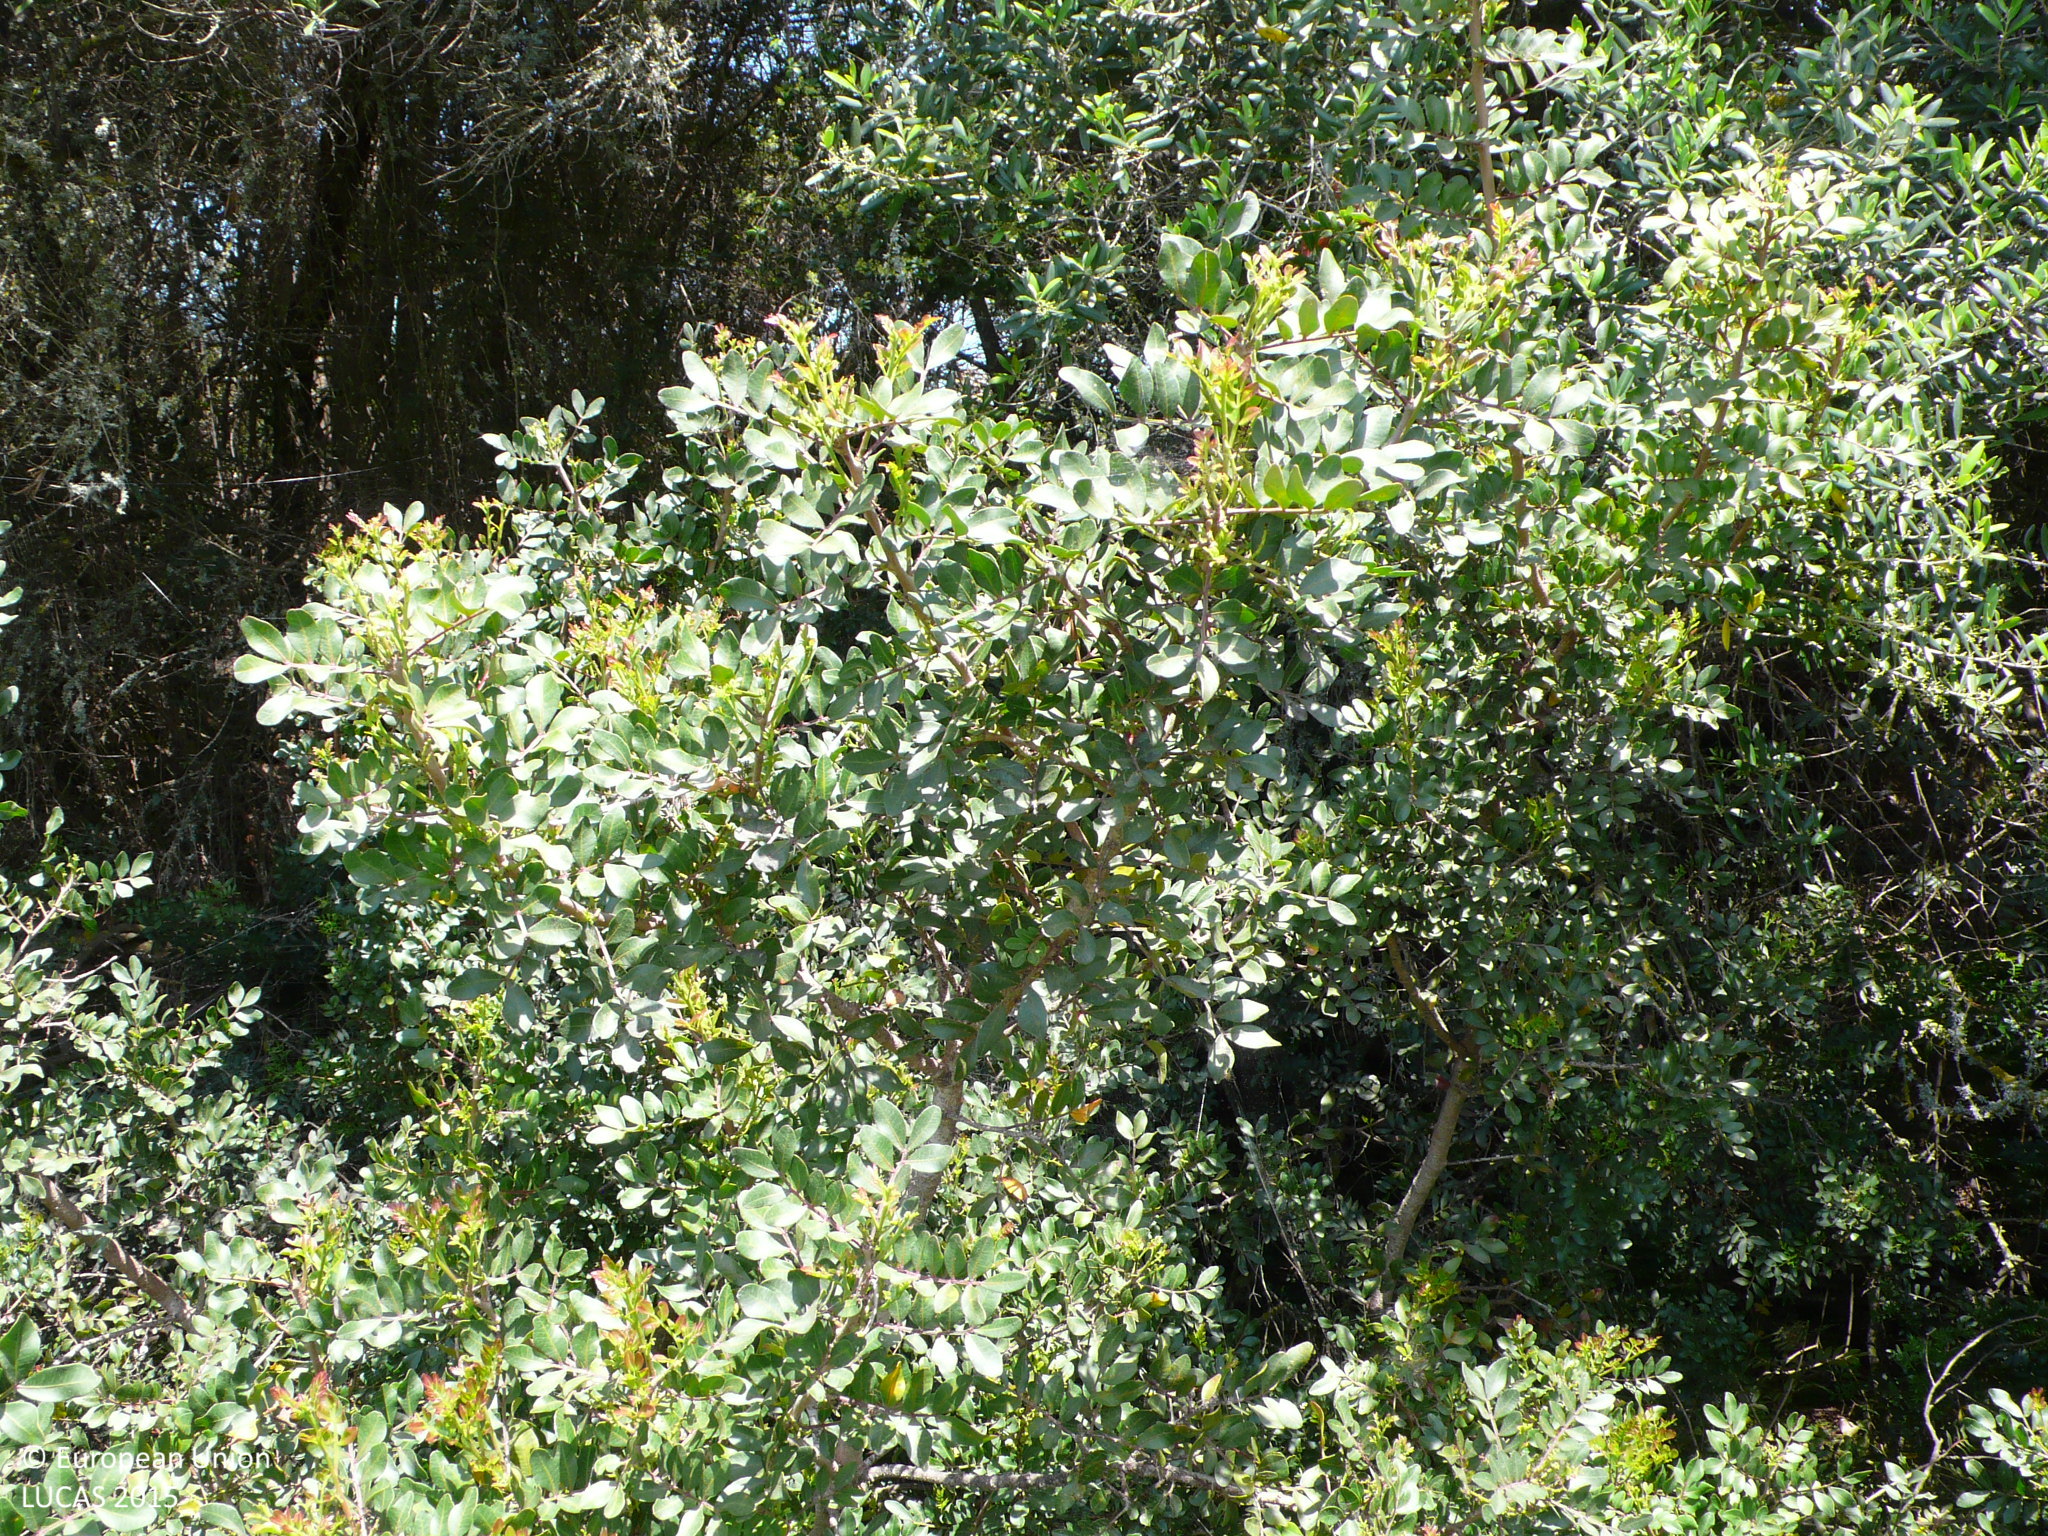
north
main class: Woodland
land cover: Broadleaved woodland
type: broadleaved evergreen forest
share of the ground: 50 - 75 %
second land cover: Grassland without tree/shrub cover
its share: 50 - 75 %
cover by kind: broadleaved forest trees 55 %, herbaceous plants 35 %, shrubs 10 %
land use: Forestry
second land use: Agriculture (excluding fallow land and kitchen gardens)
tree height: > 5 m
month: May
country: ES
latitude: 39.9232
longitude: 4.0476
